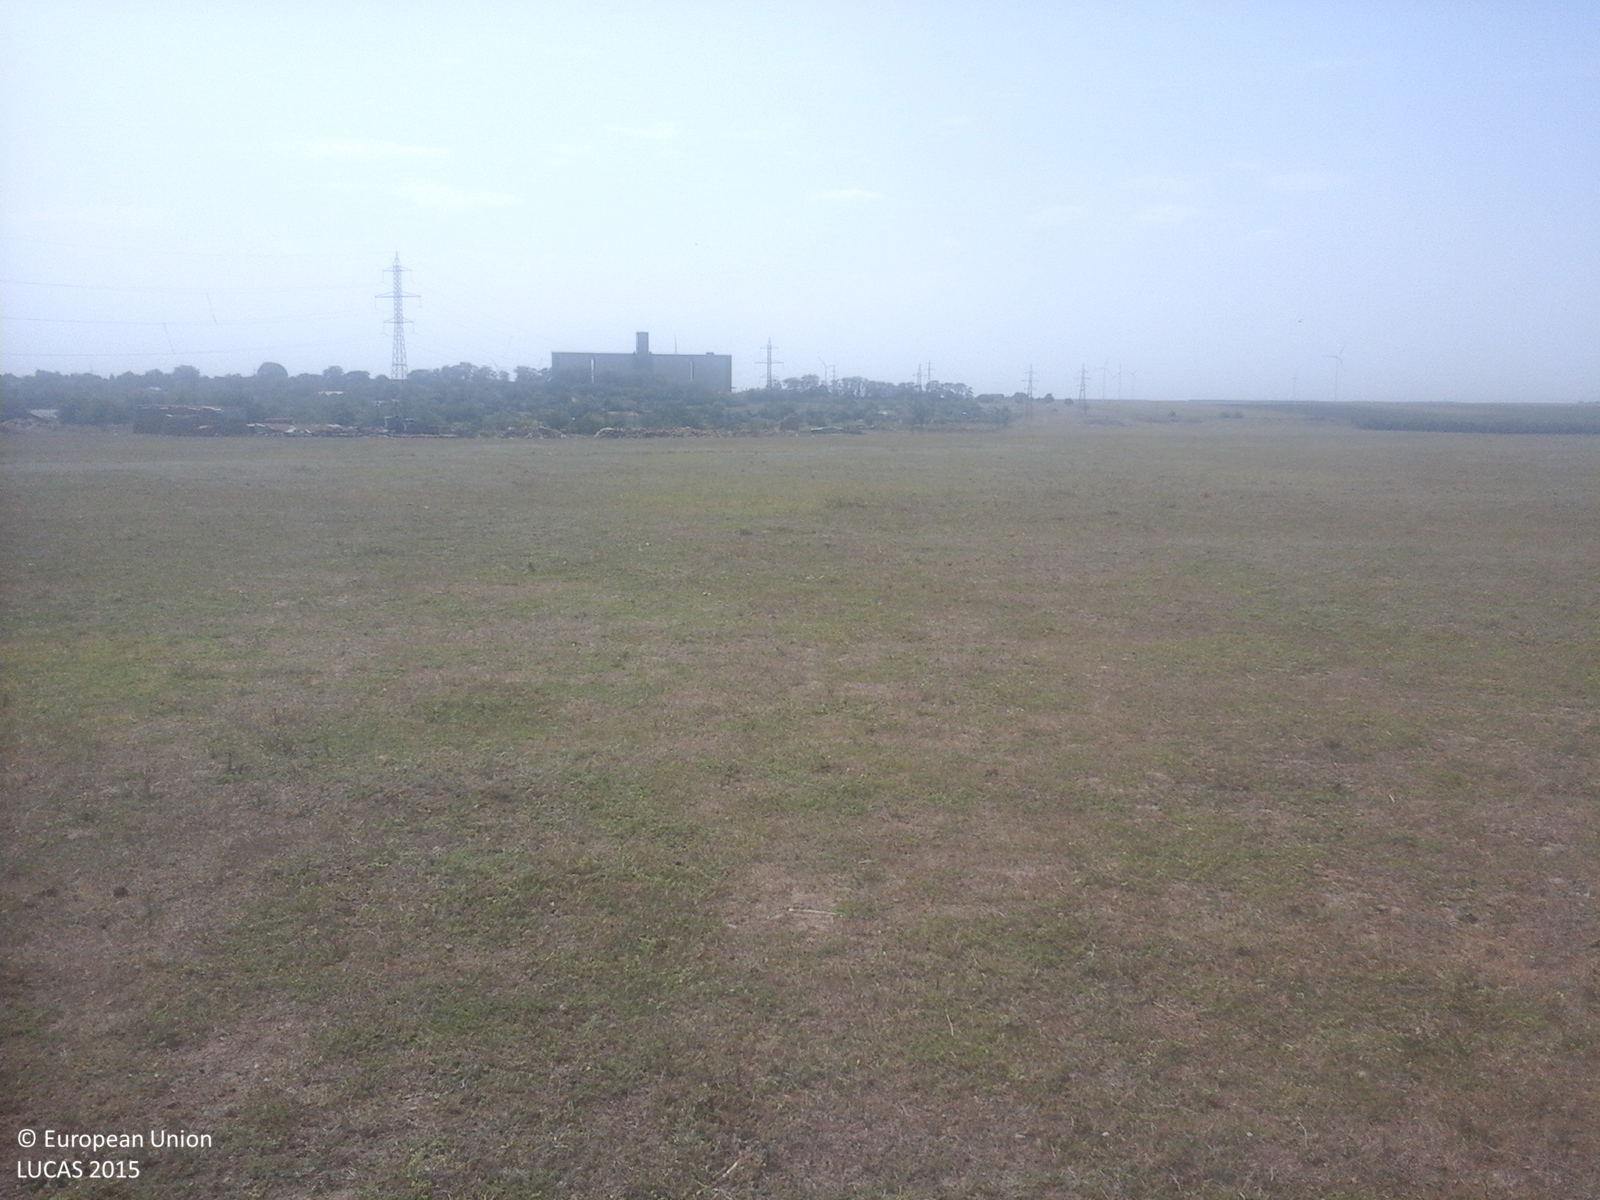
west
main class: Grassland
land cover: Grassland without tree/shrub cover
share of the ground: > 75 %
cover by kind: herbaceous plants 100 %
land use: Agriculture (excluding fallow land and kitchen gardens)
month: August
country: RO
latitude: 44.1104
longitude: 28.2912
